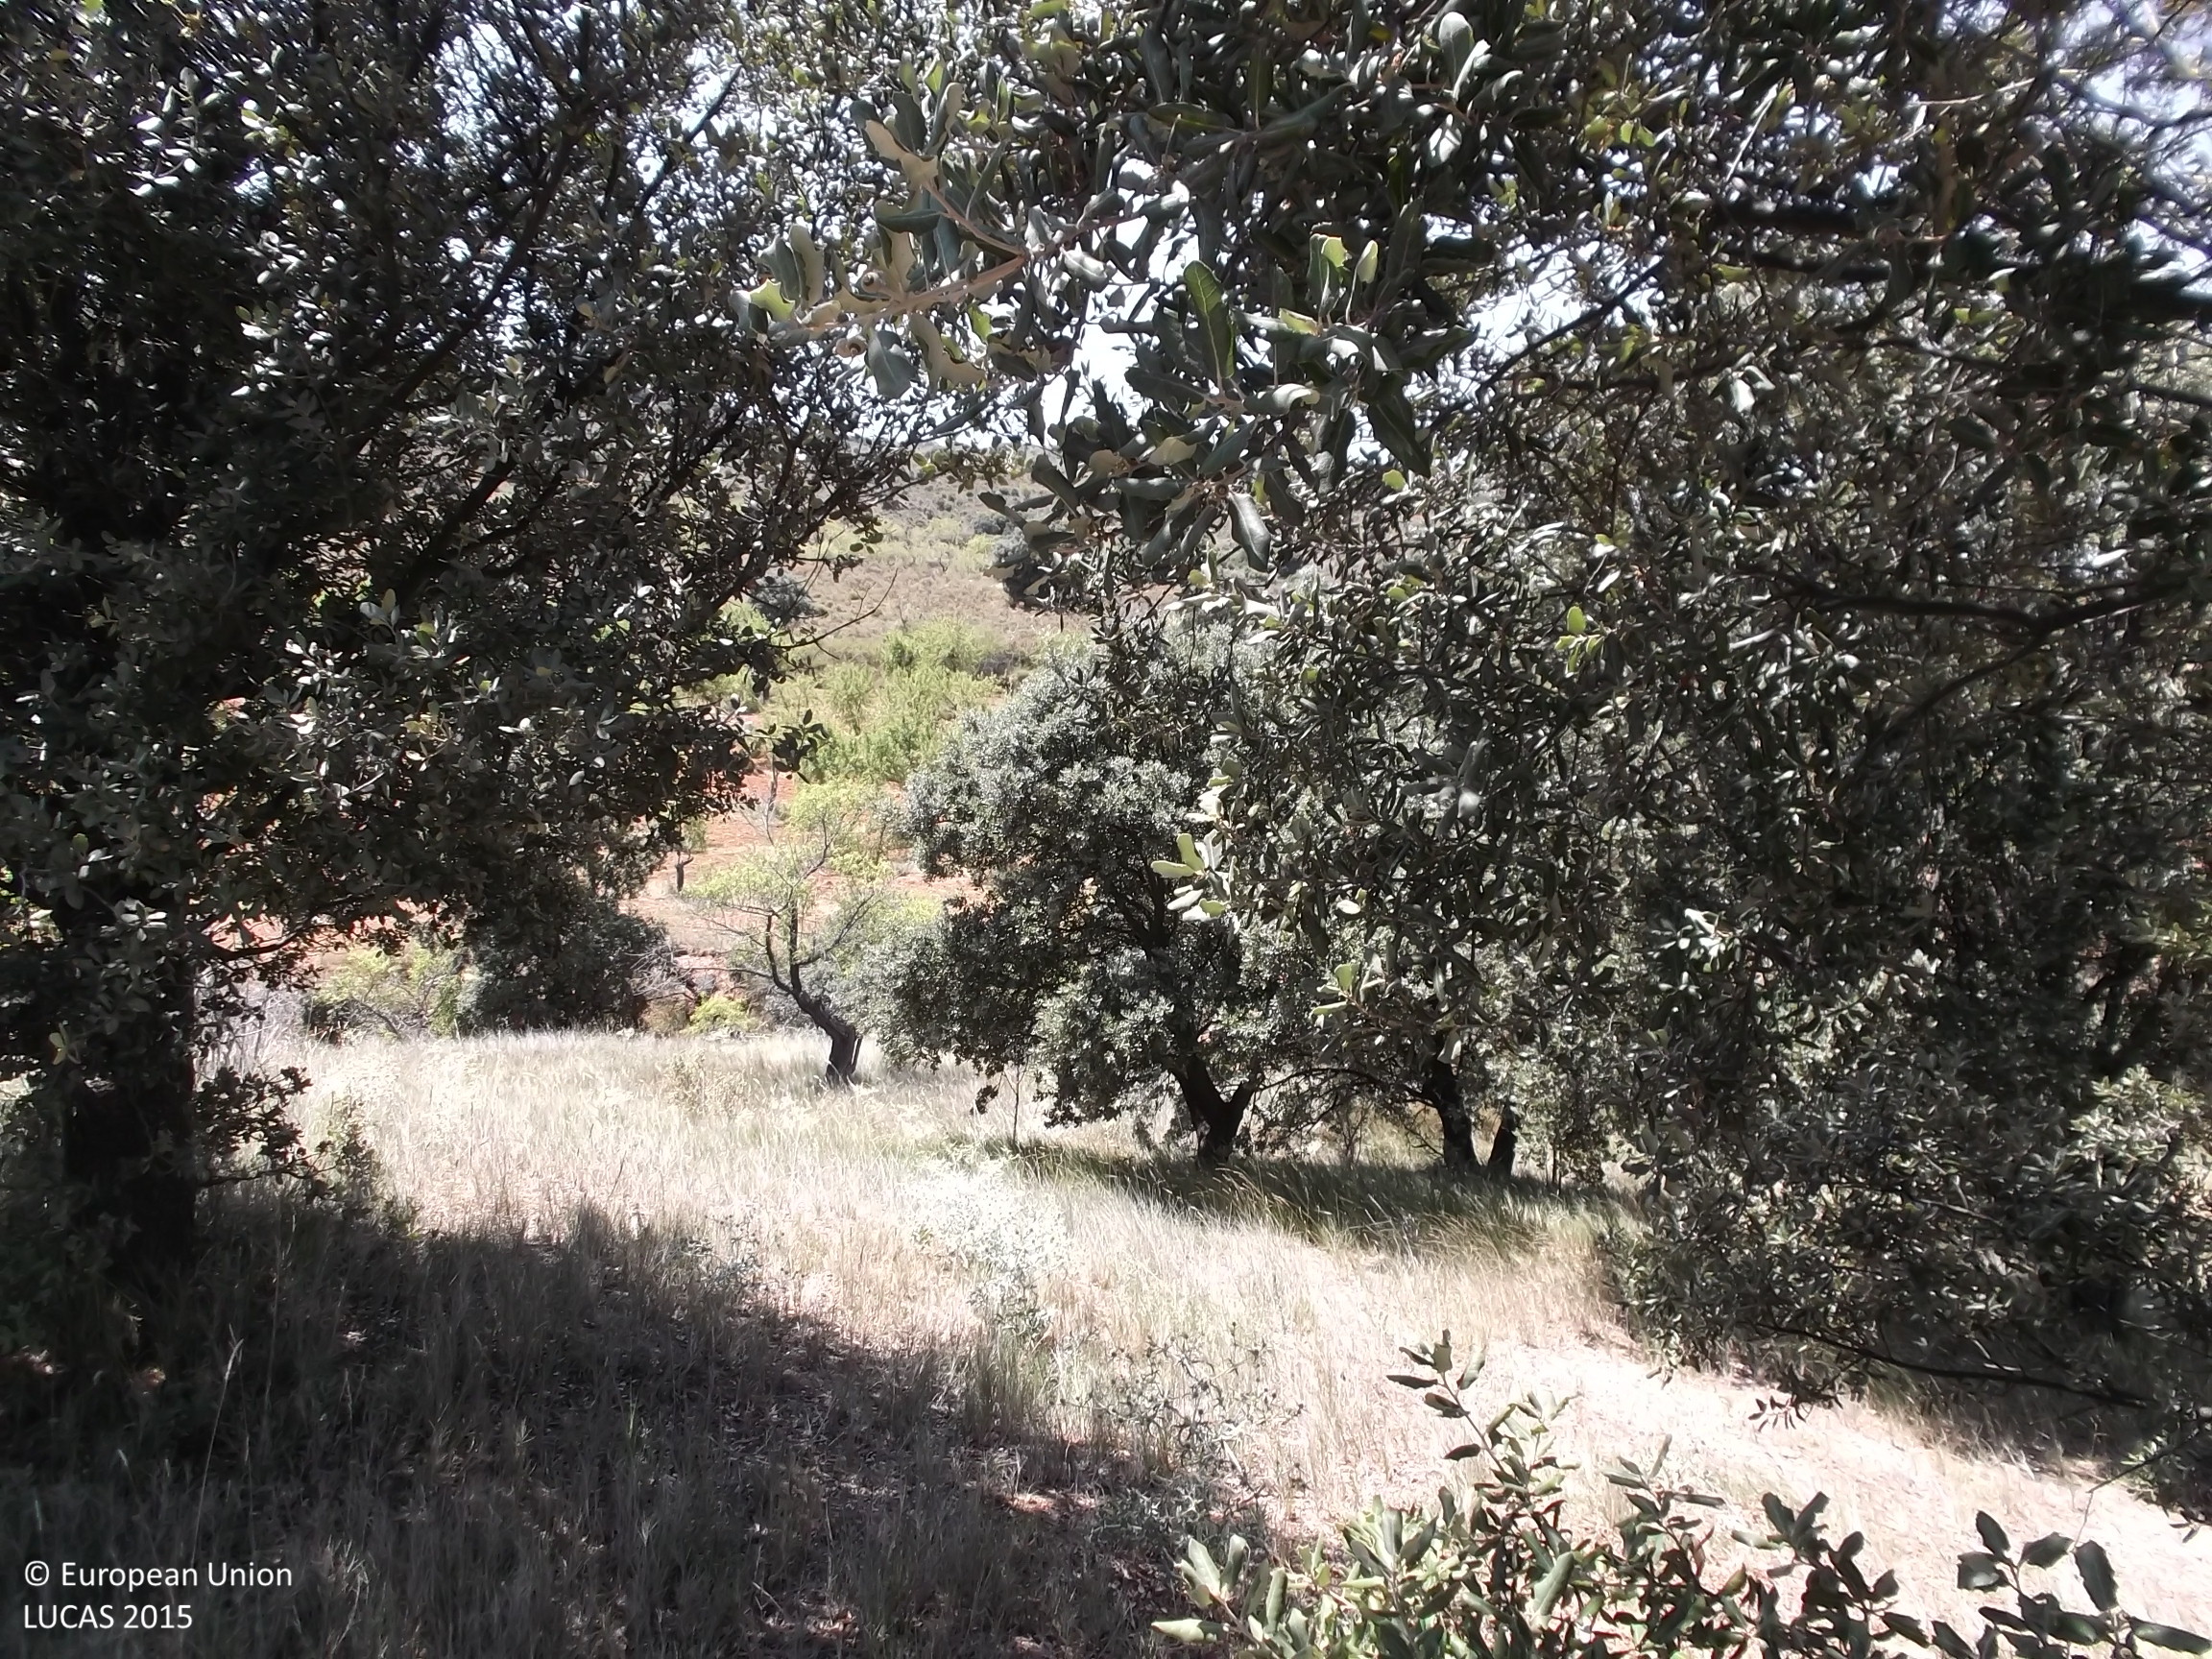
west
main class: Woodland
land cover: Broadleaved woodland
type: broadleaved evergreen forest
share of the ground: 10 - 25 %
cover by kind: herbaceous plants 60 %, shrubs 20 %, broadleaved forest trees 15 %, unconsolidated bare surface 5 %
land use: Semi-natural and natural areas not in use
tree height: > 5 m
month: July
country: ES
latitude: 42.1680
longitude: -2.0574
